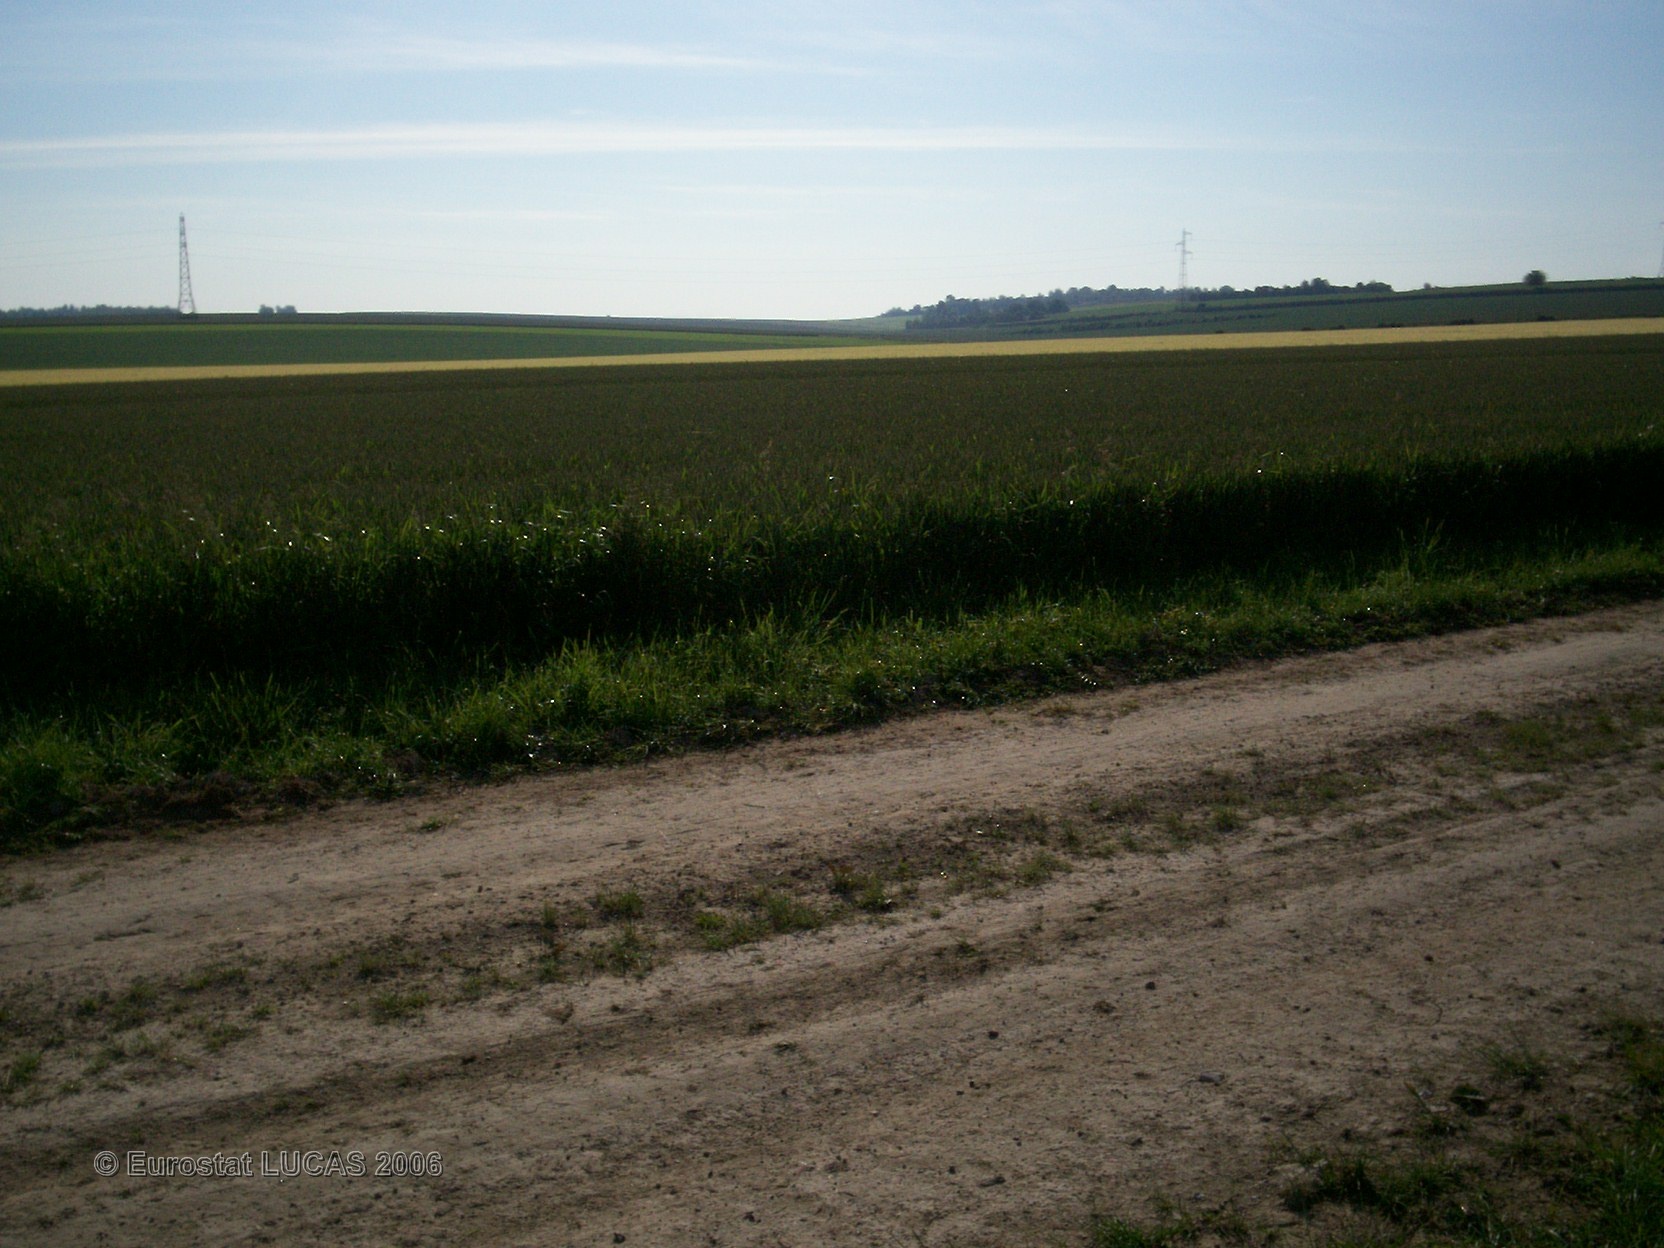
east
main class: Cropland
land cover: Lucerne
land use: Agriculture (excluding fallow land and kitchen gardens)
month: June
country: FR
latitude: 48.8964
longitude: 4.4723
